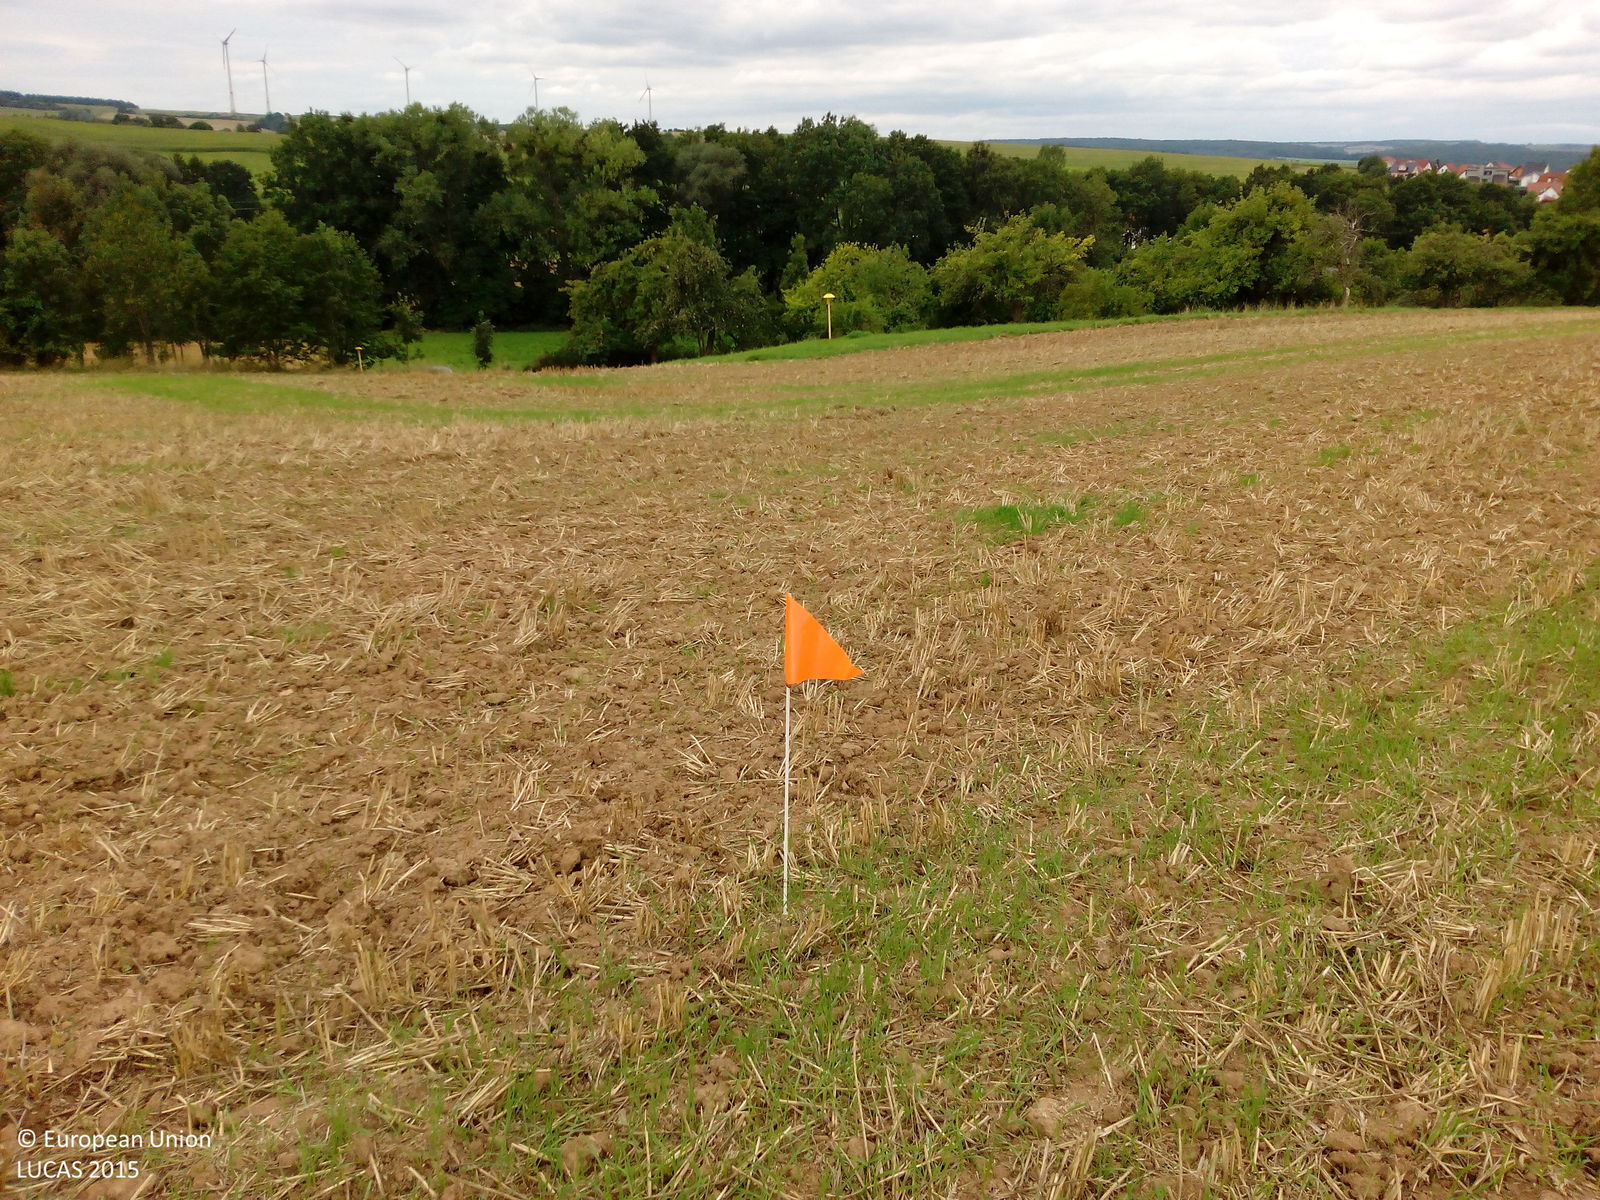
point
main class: Cropland
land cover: Common wheat
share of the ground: 25 - 50 %
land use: Agriculture (excluding fallow land and kitchen gardens)
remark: Harvested field
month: August
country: DE
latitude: 51.0647
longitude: 10.3566
